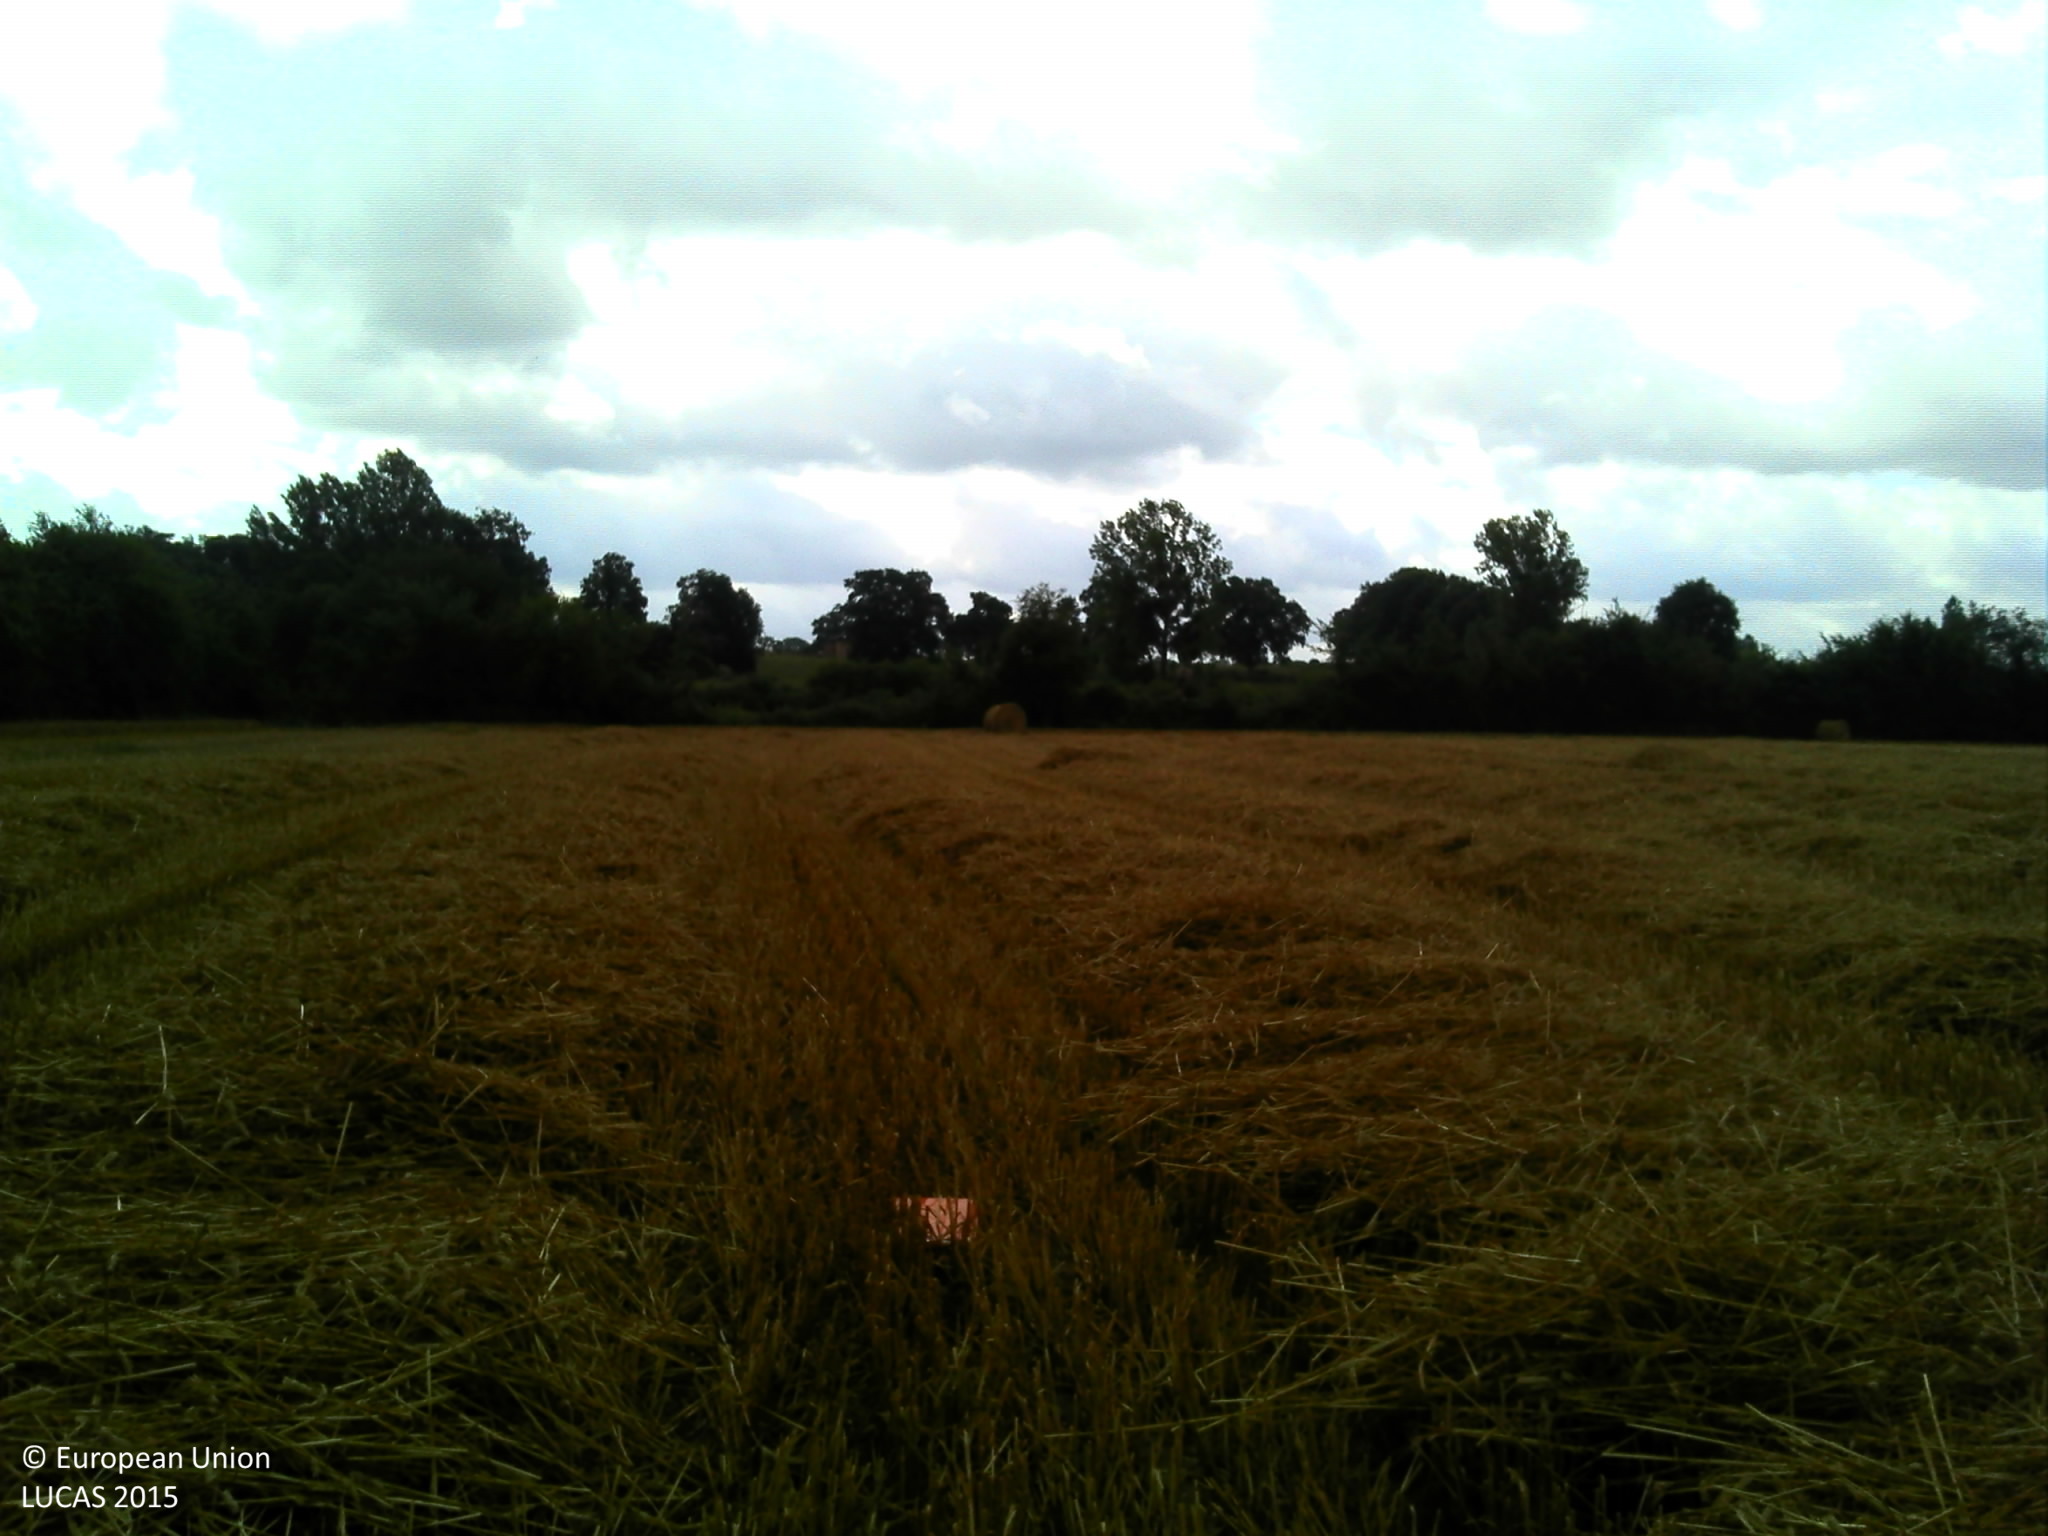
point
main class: Cropland
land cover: Triticale
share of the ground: > 75 %
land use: Agriculture (excluding fallow land and kitchen gardens)
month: July
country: FR
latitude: 47.7542
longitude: 0.2508
